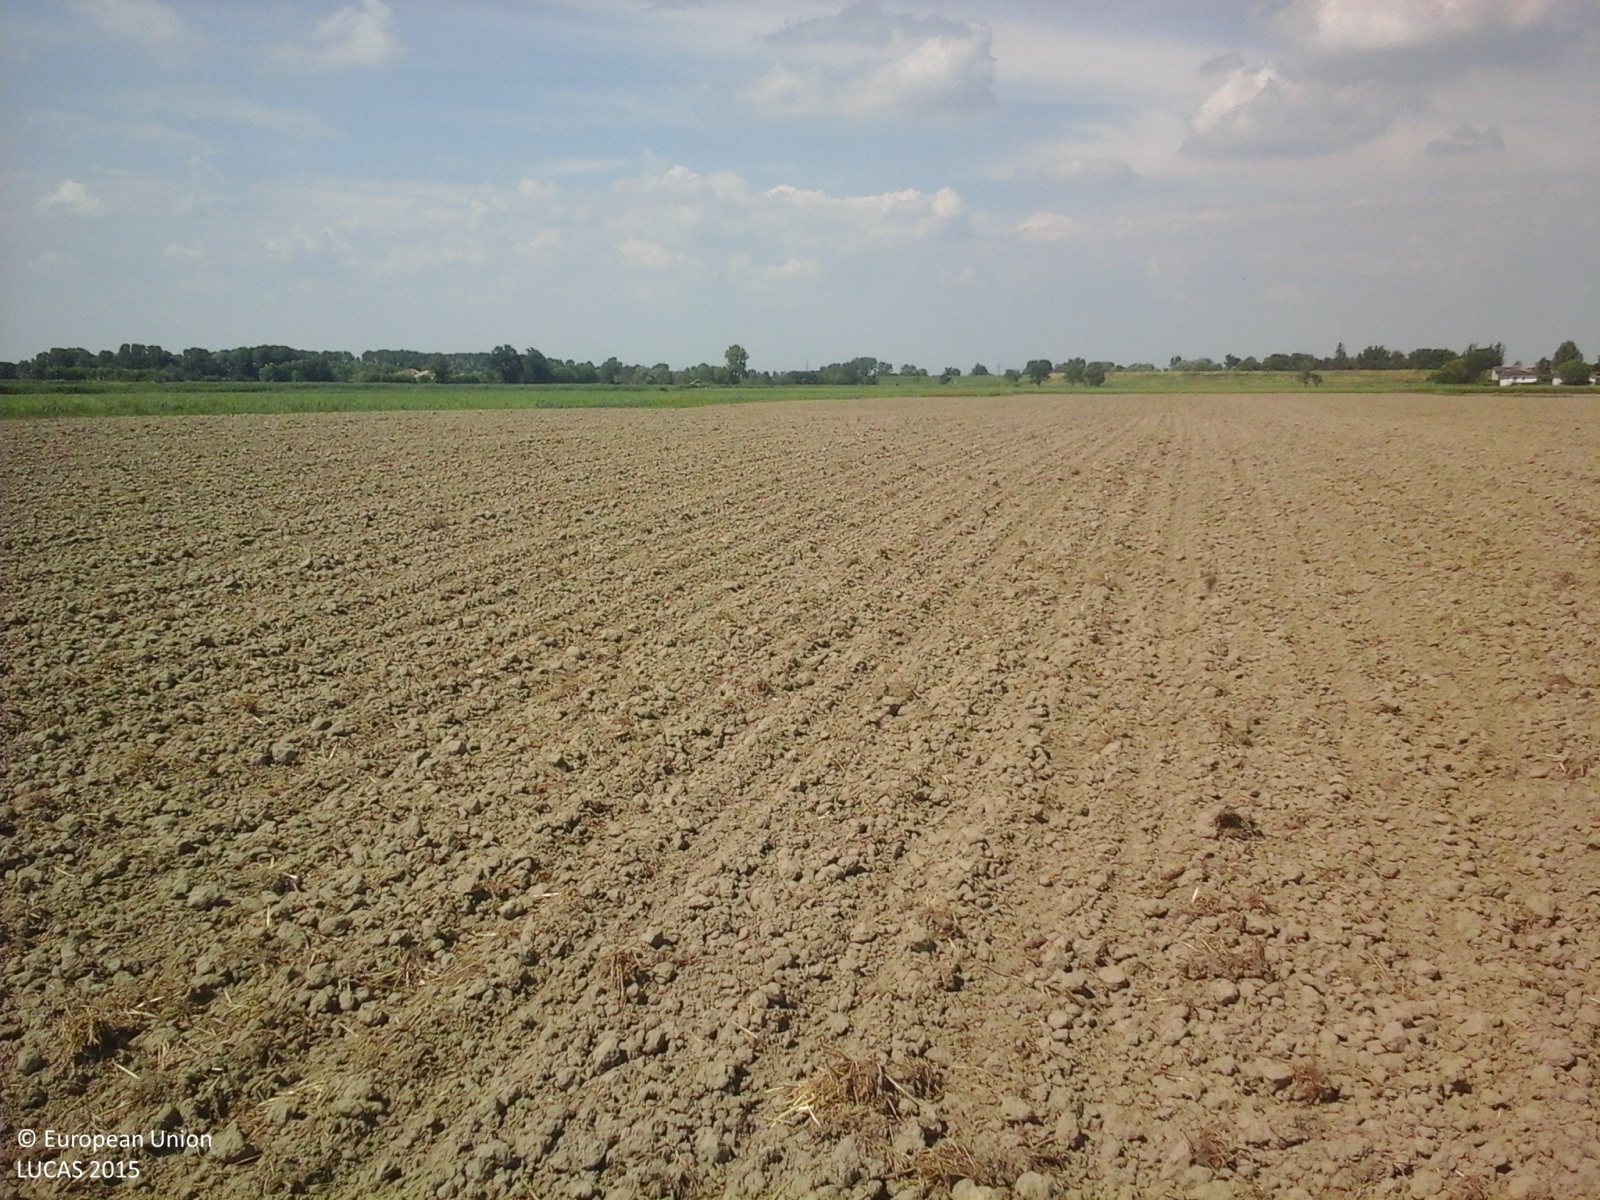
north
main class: Cropland
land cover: Maize
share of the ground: < 10 %
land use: Agriculture (excluding fallow land and kitchen gardens)
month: May
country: IT
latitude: 45.0858
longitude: 10.9257
